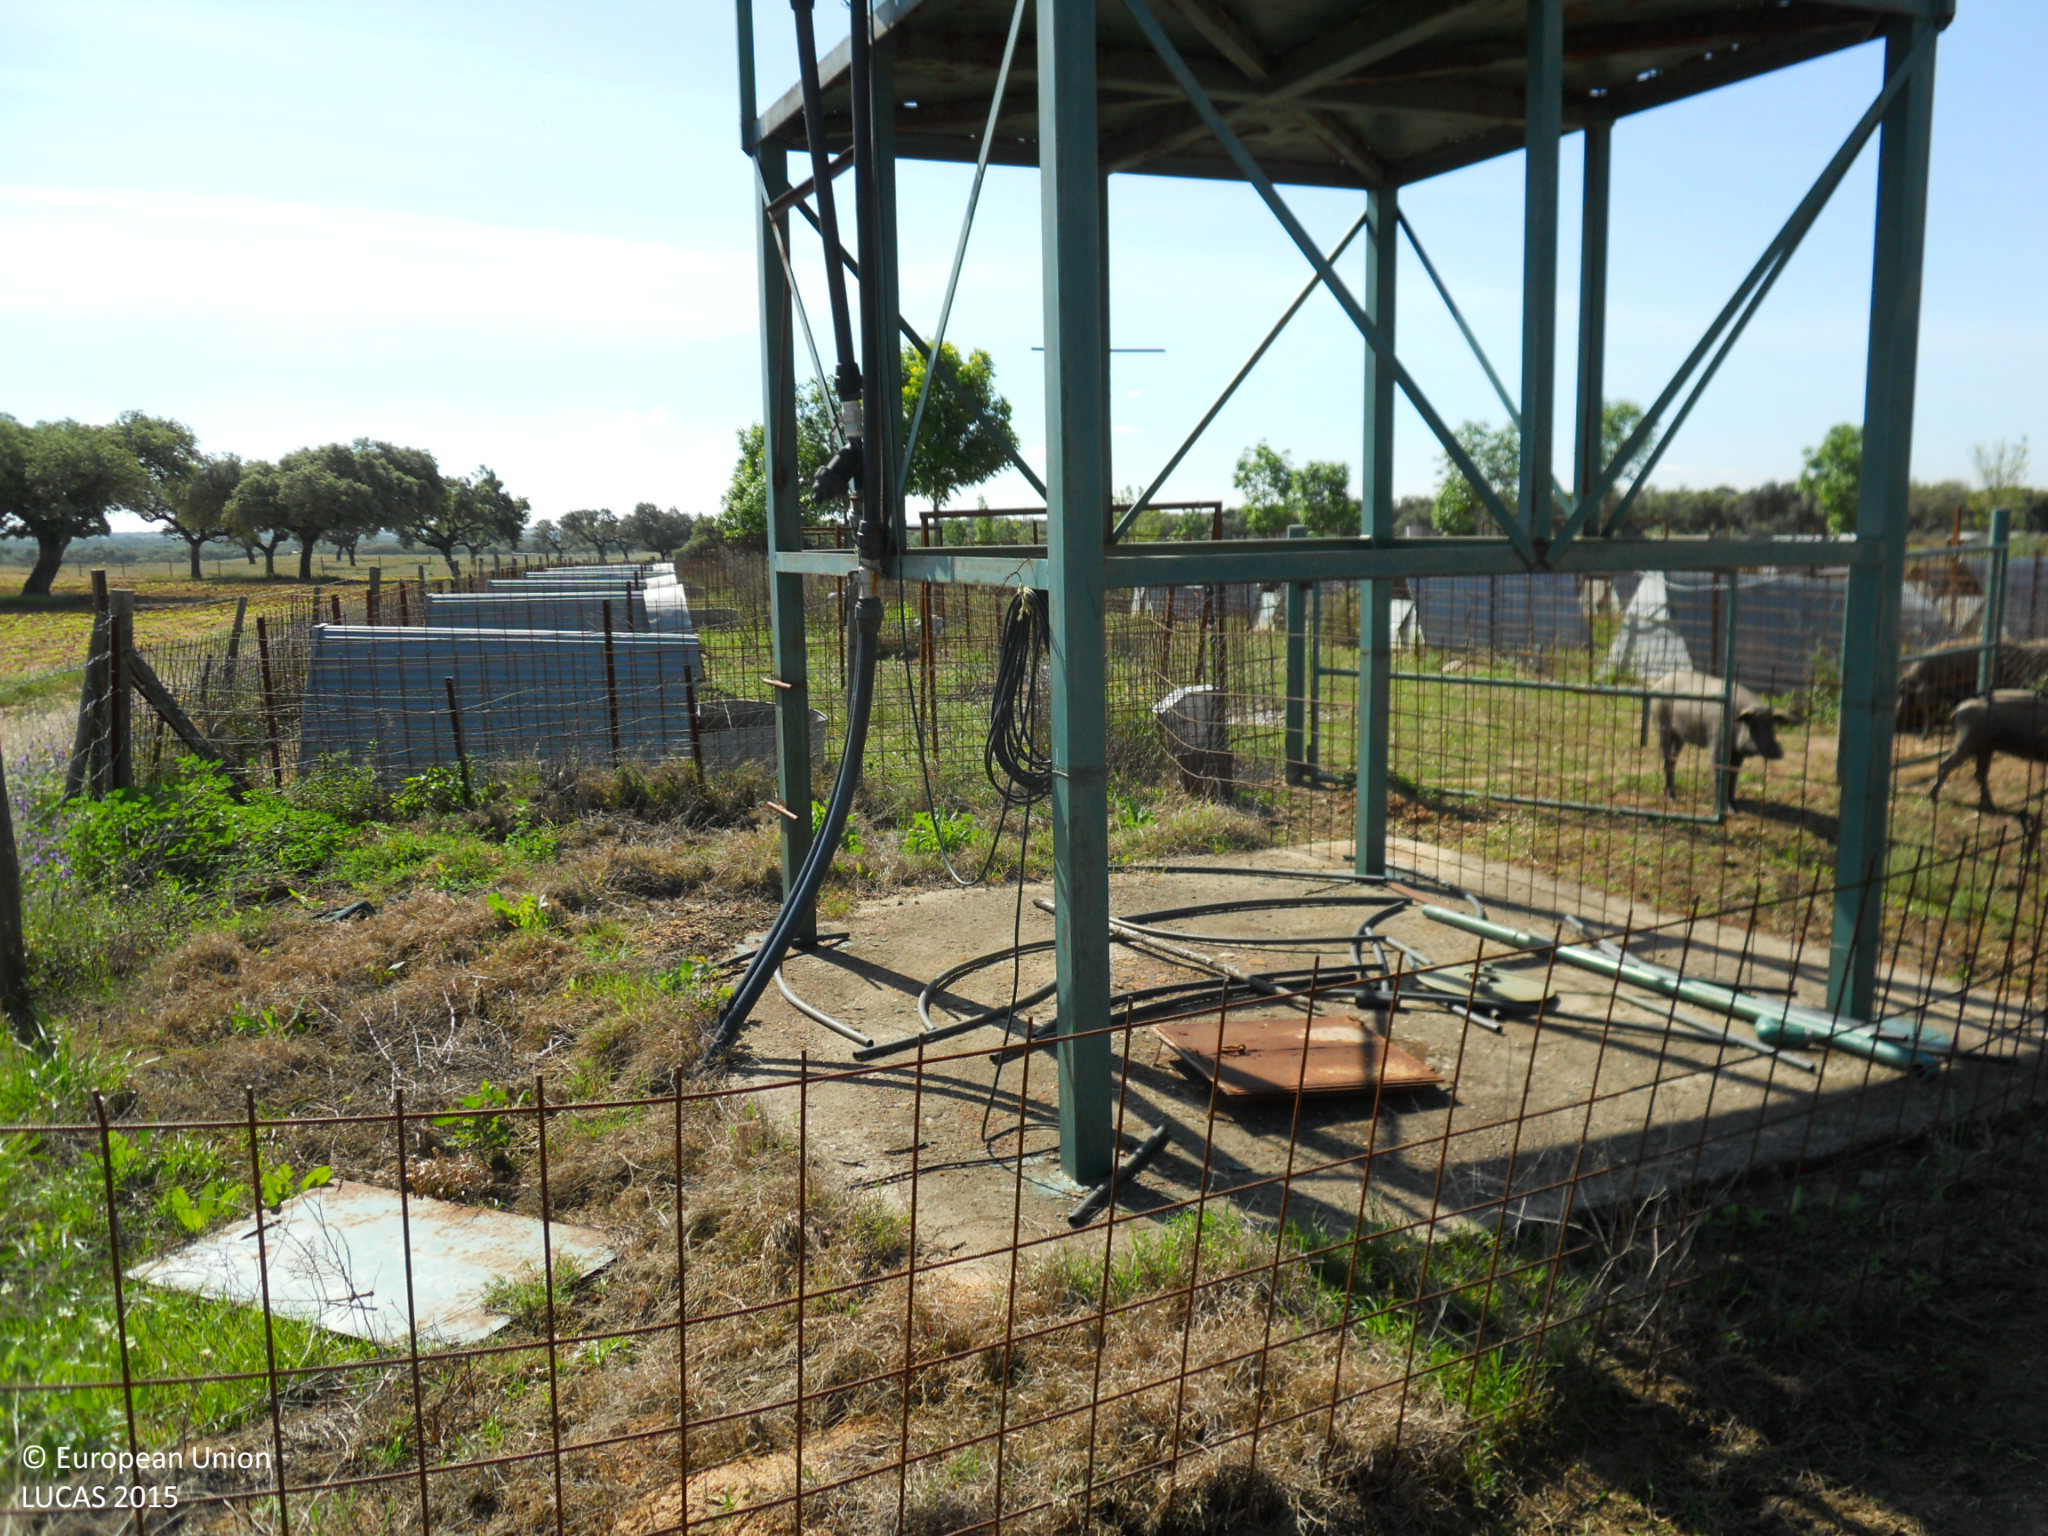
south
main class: Cropland
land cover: Sunflower
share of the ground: < 10 %
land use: Agriculture (excluding fallow land and kitchen gardens)
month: April
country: ES
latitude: 39.0407
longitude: -6.8337
